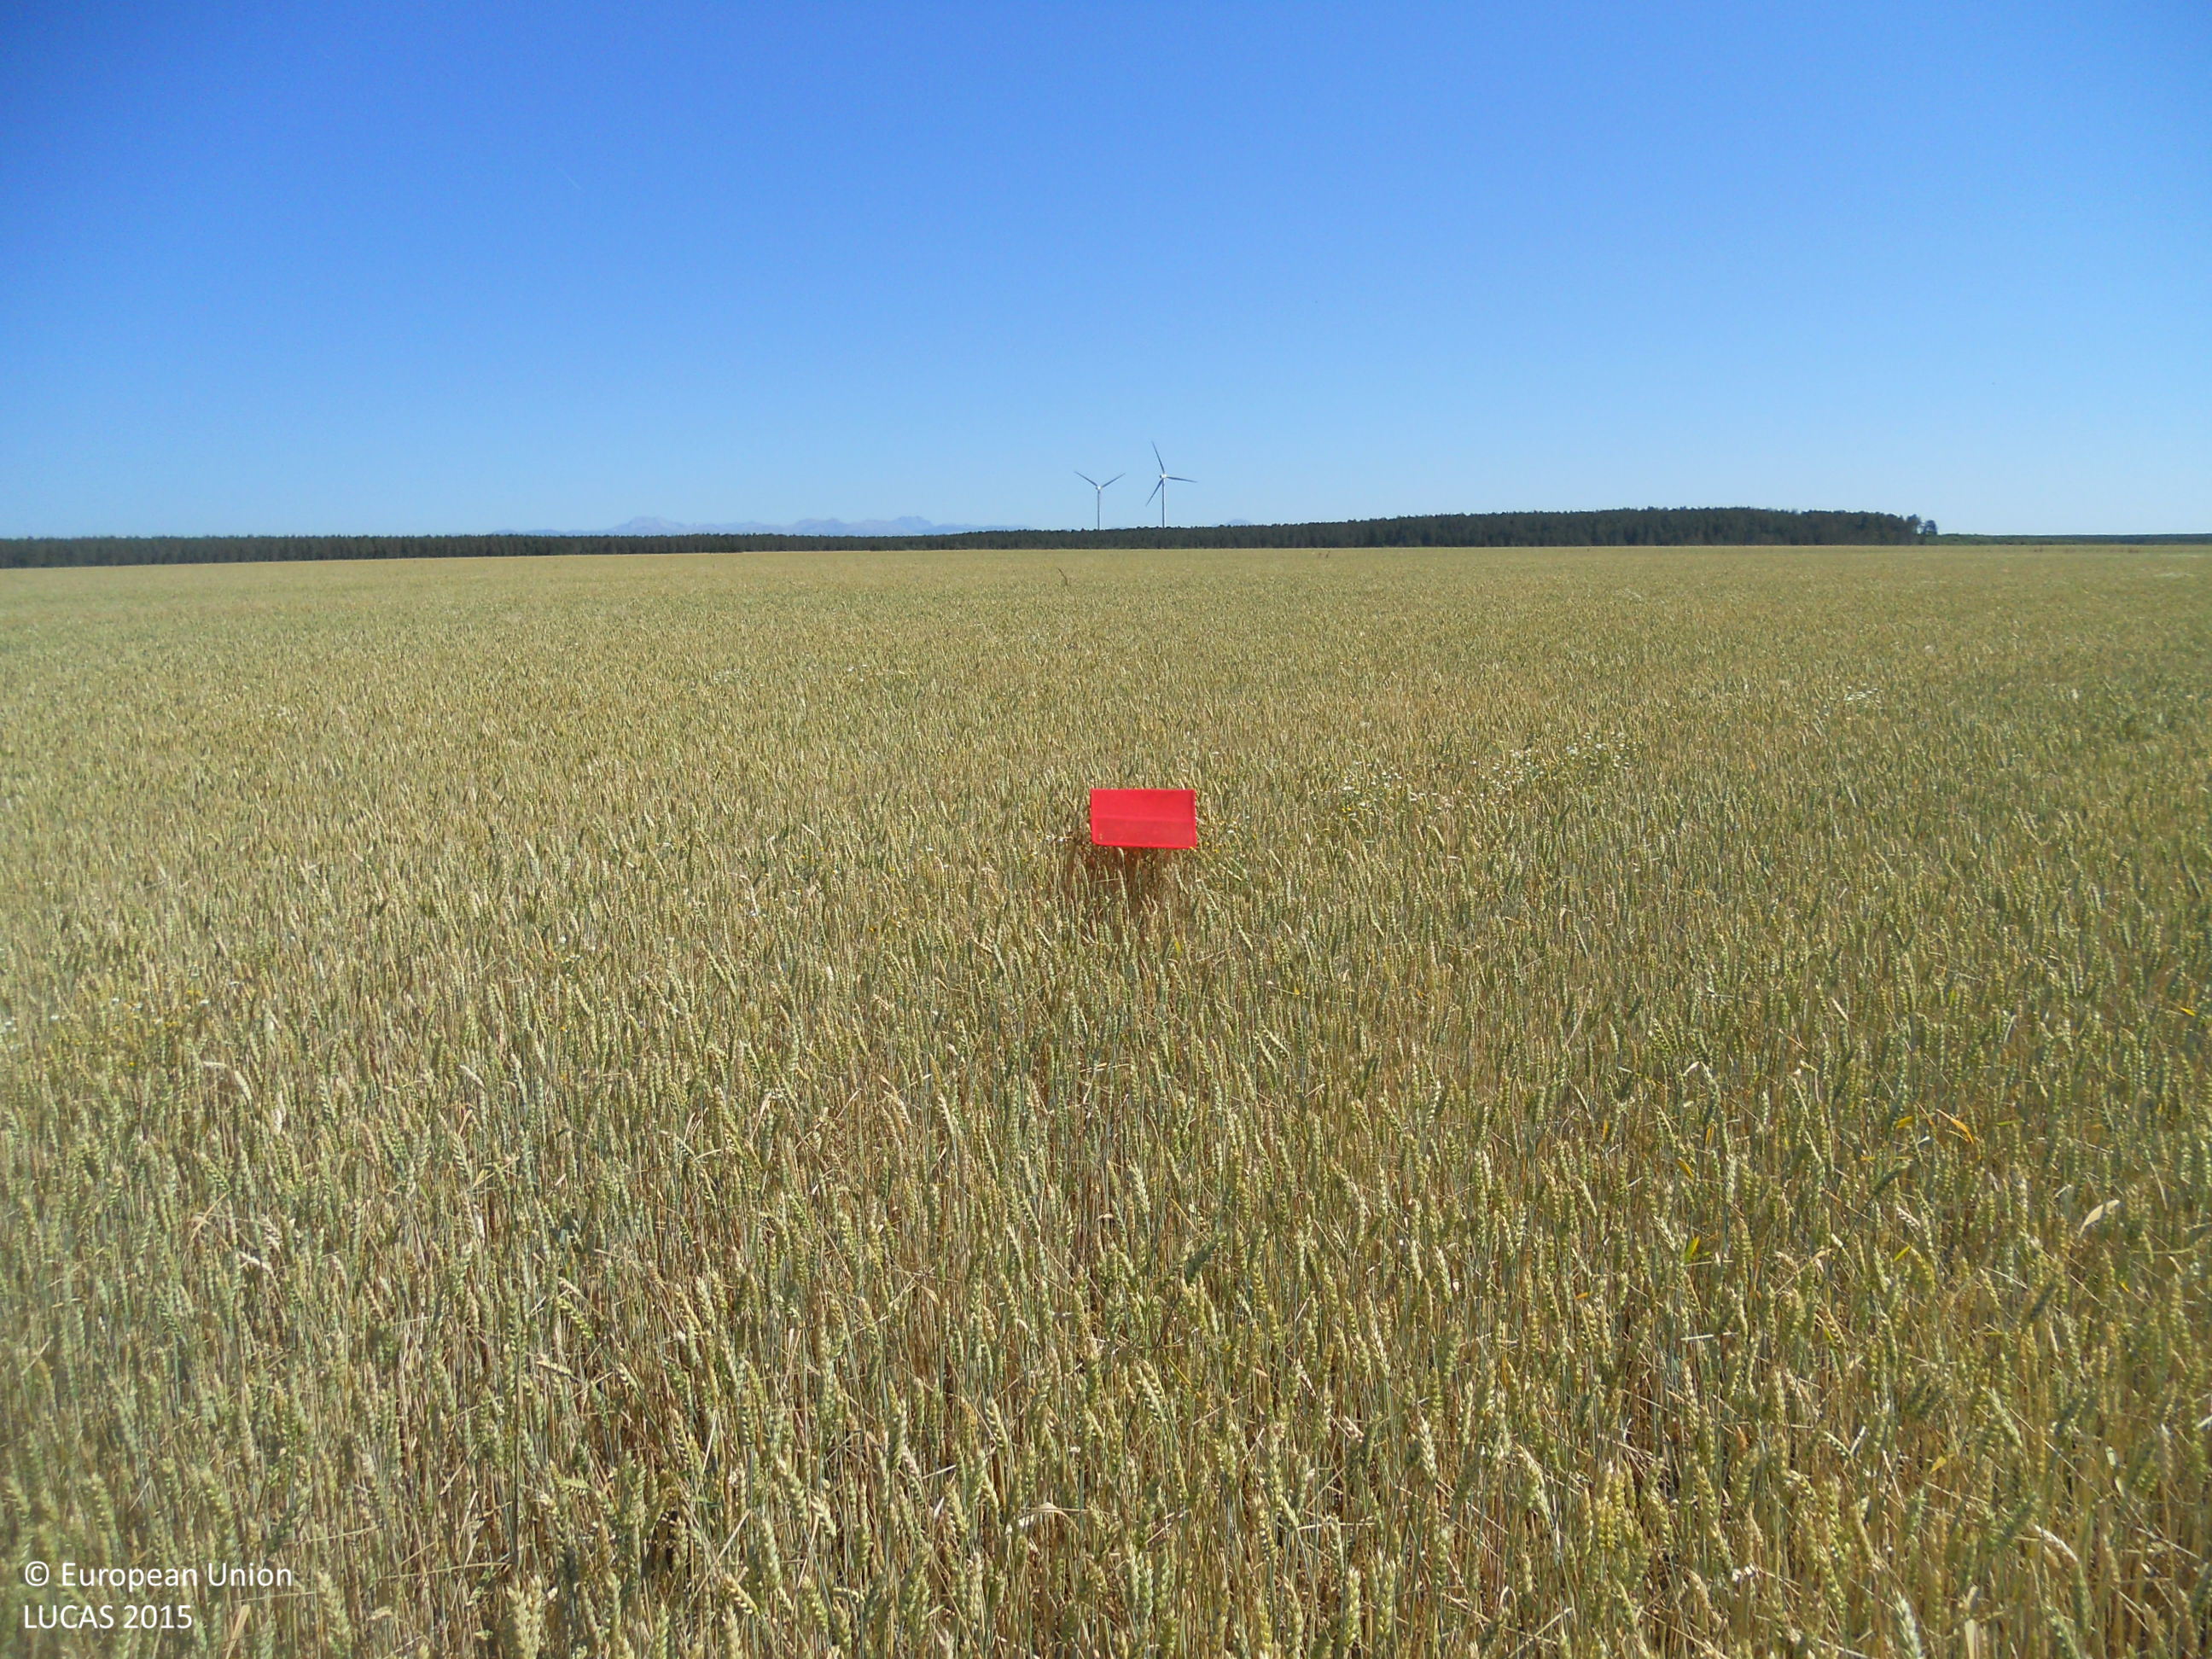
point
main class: Cropland
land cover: Common wheat
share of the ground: > 75 %
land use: Agriculture (excluding fallow land and kitchen gardens)
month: June
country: ES
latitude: 42.4605
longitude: -4.9064
